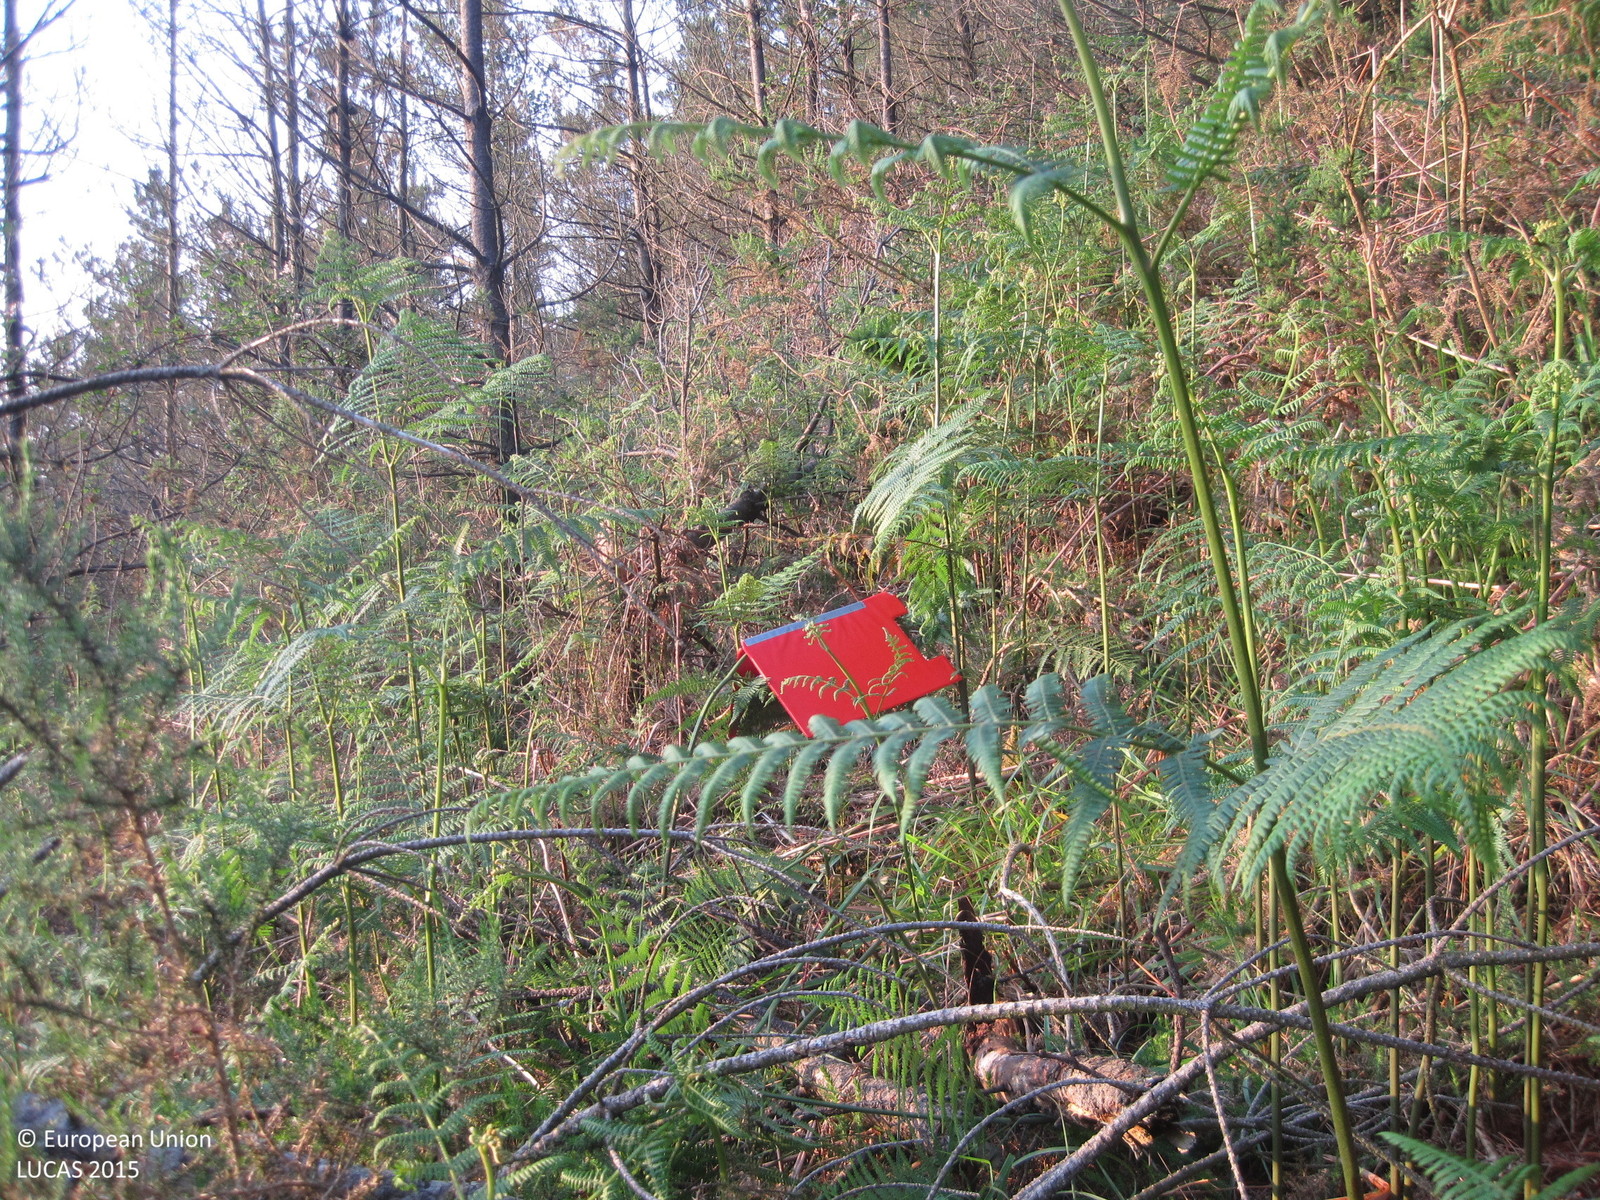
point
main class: Woodland
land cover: Pine dominated coniferous woodland
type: hemiboreal forest and nemoral coniferous forest and mixed broadleaved-coniferous forest
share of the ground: > 75 %
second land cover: Grassland without tree/shrub cover
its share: > 75 %
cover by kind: coniferous forest trees 90 %, shrubs 5 %, herbaceous plants 5 %
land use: Forestry
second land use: Agriculture (excluding fallow land and kitchen gardens)
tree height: > 5 m
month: June
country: ES
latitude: 43.1602
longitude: -1.8387
